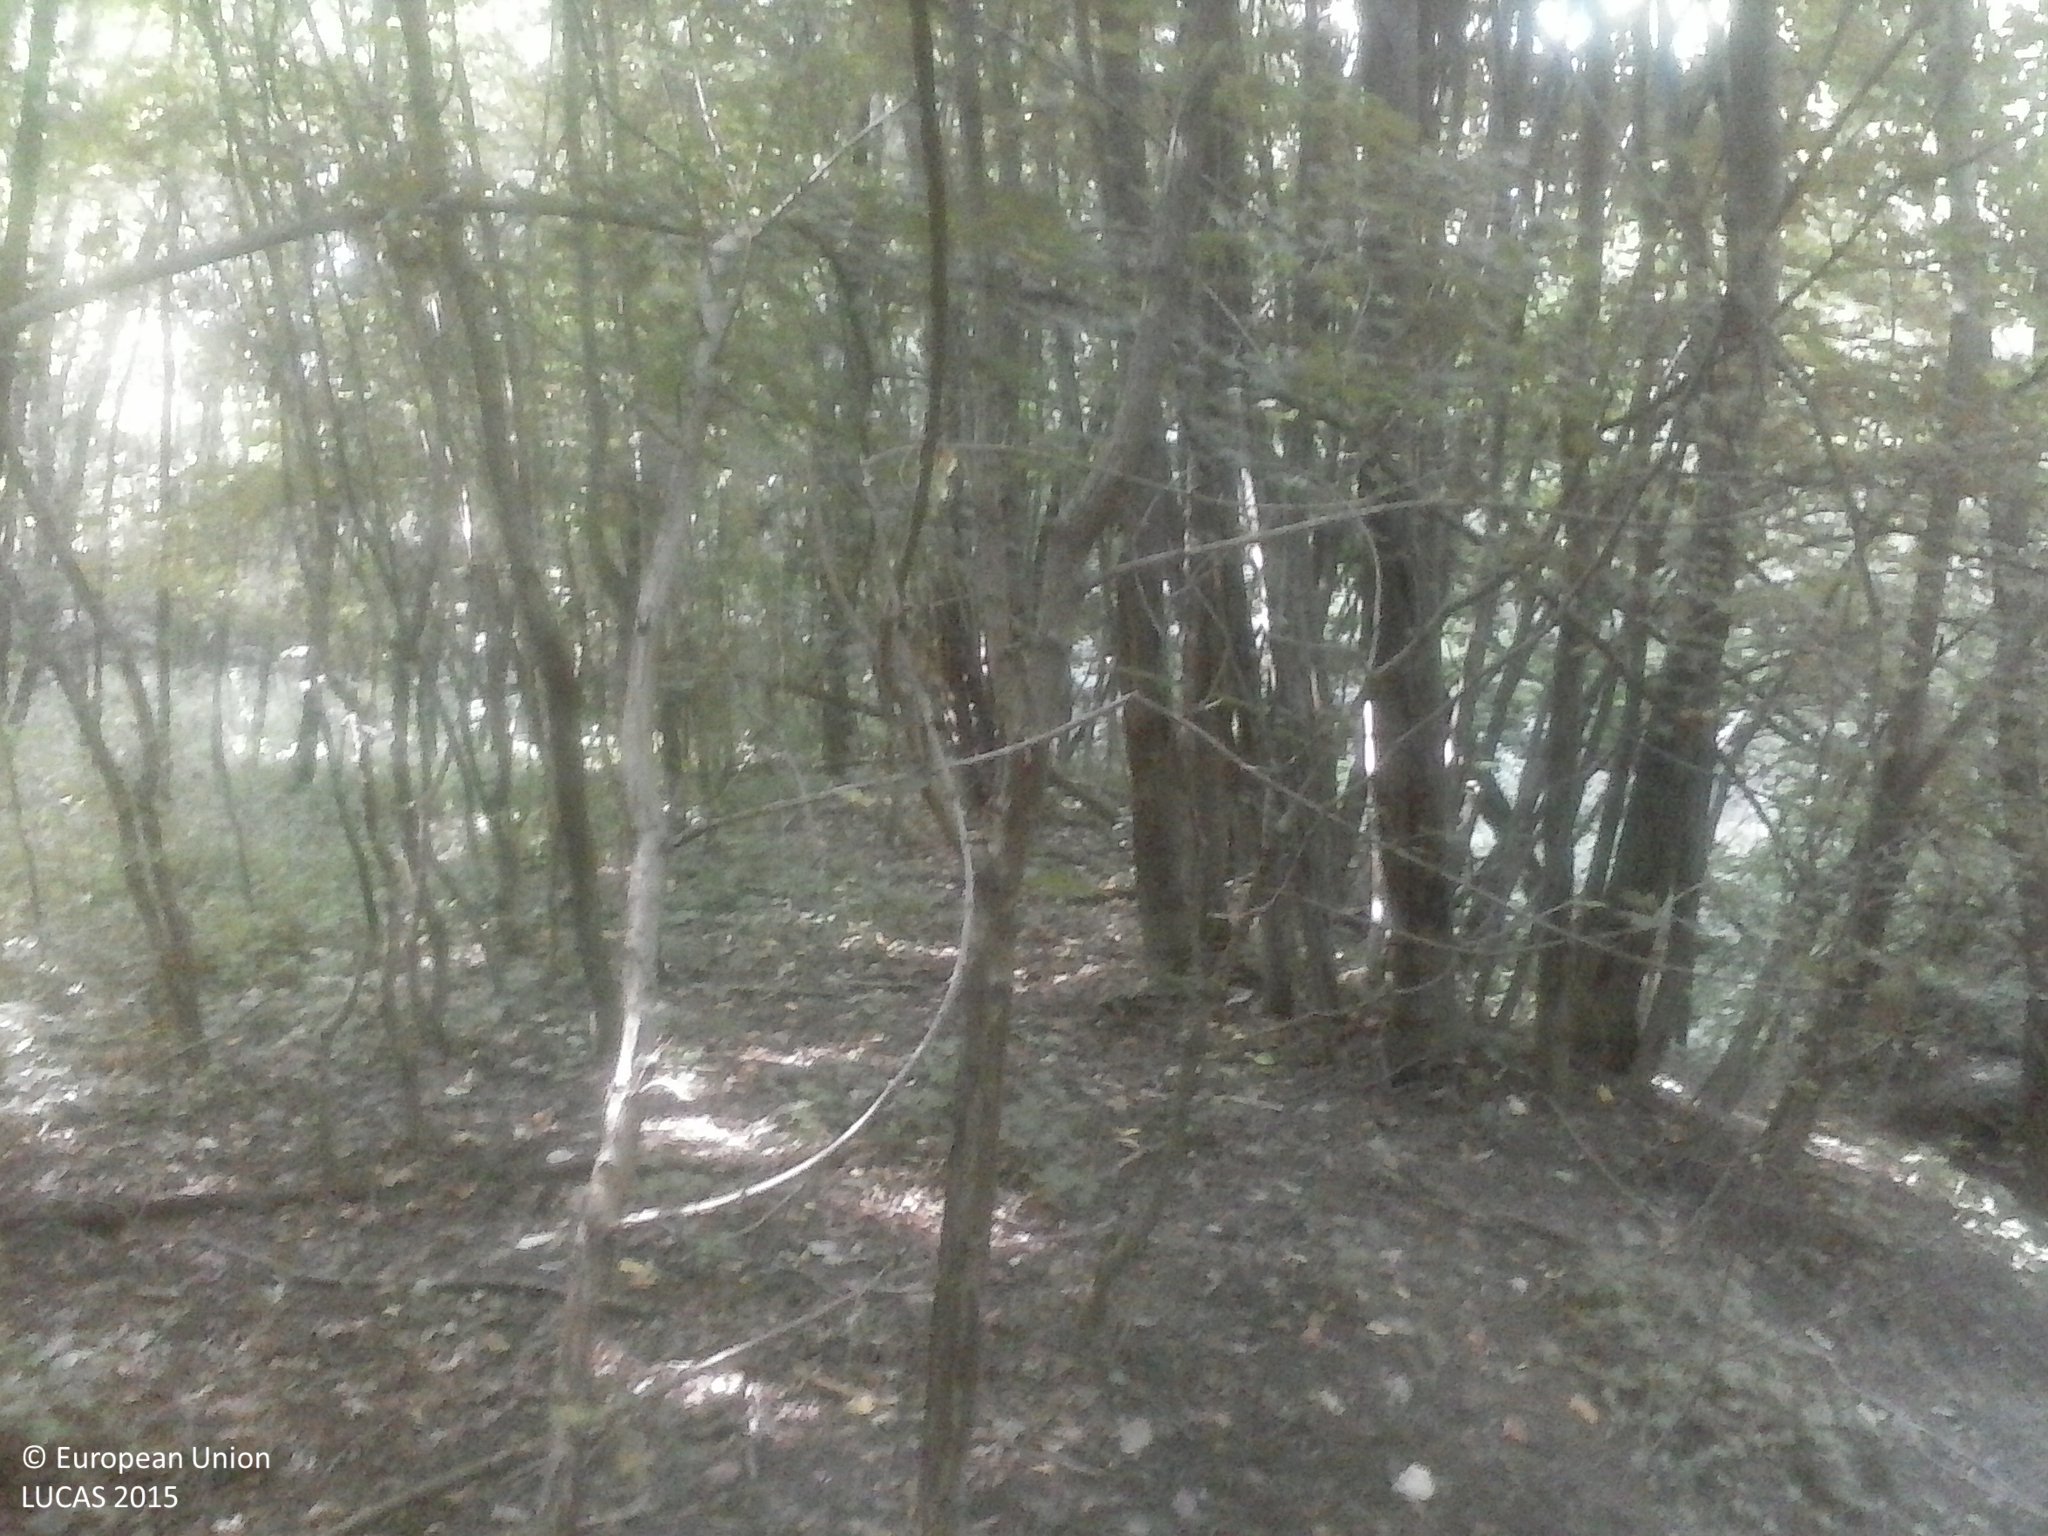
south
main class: Woodland
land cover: Broadleaved woodland
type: mesophytic deciduous forest
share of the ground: > 75 %
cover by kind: broadleaved forest trees 90 %, shrubs 5 %, herbaceous plants 5 %
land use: Semi-natural and natural areas not in use
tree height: > 5 m
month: August
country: HU
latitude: 46.2093
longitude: 17.8212
